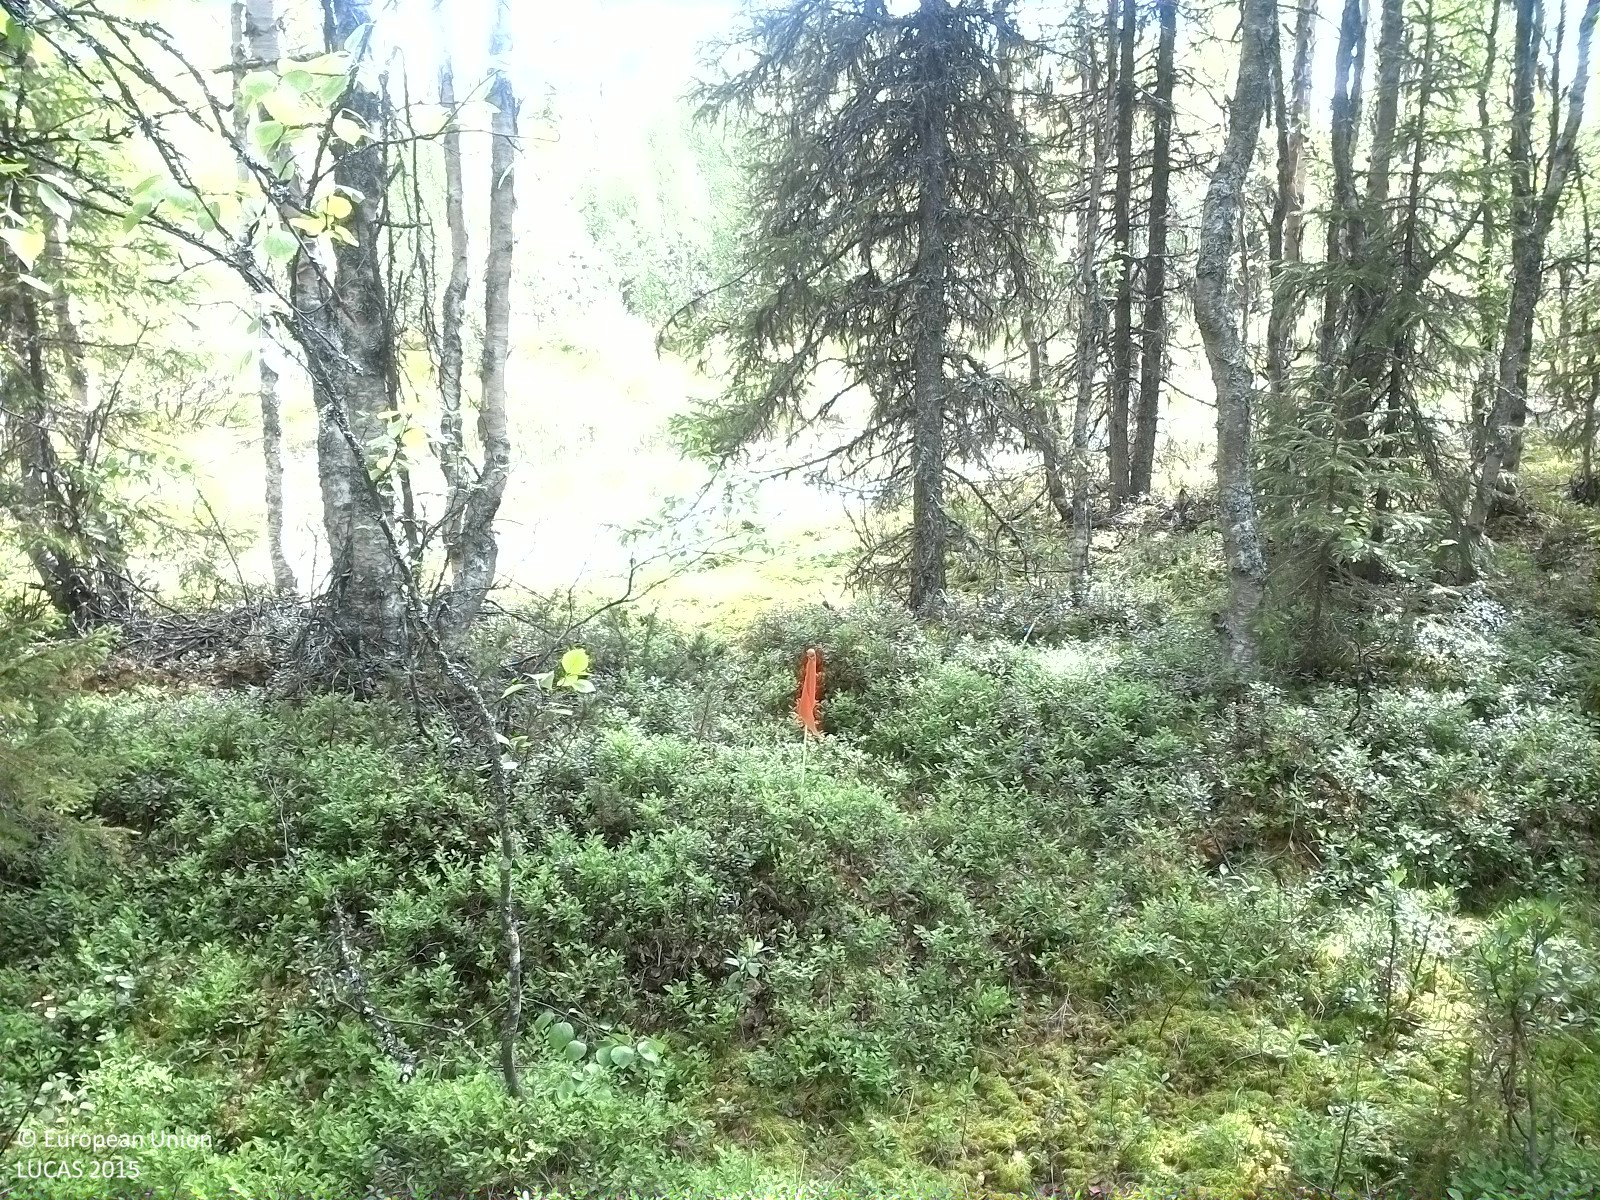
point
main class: Woodland
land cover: Spruce dominated mixed woodland
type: boreal forest
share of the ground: > 75 %
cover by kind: coniferous forest trees 65 %, broadleaved forest trees 25 %, shrubs 10 %
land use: Forestry
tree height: > 5 m
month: June
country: SE
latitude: 63.5314
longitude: 15.3046
